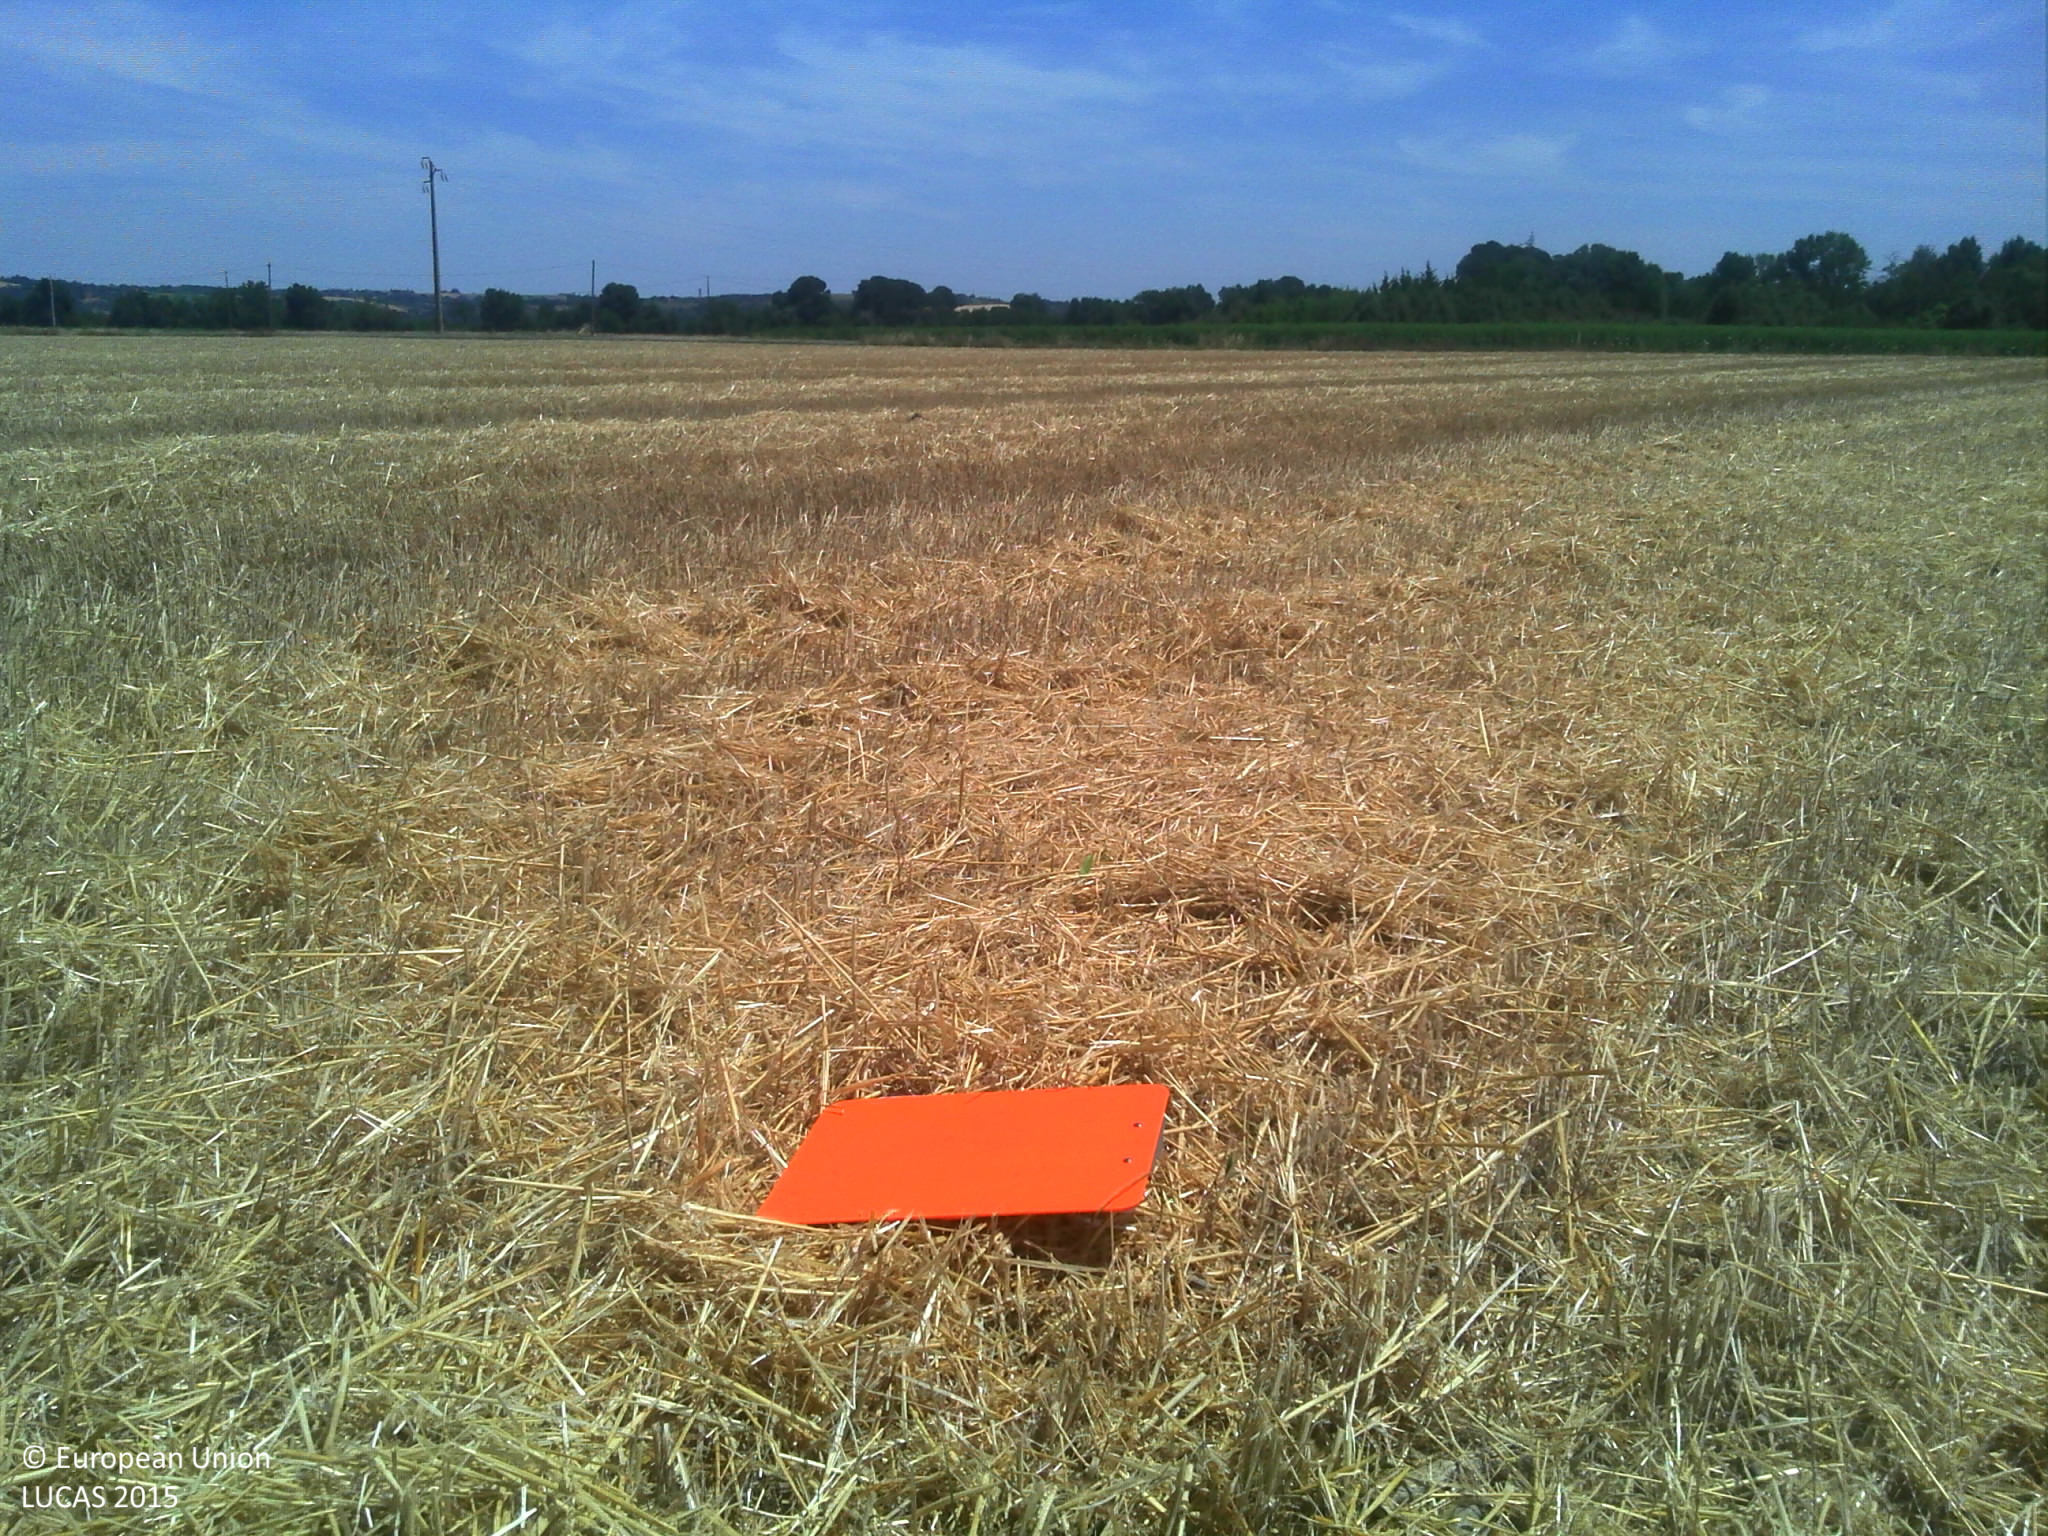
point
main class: Cropland
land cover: Common wheat
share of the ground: > 75 %
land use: Agriculture (excluding fallow land and kitchen gardens)
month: July
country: FR
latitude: 43.4303
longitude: 1.3931
